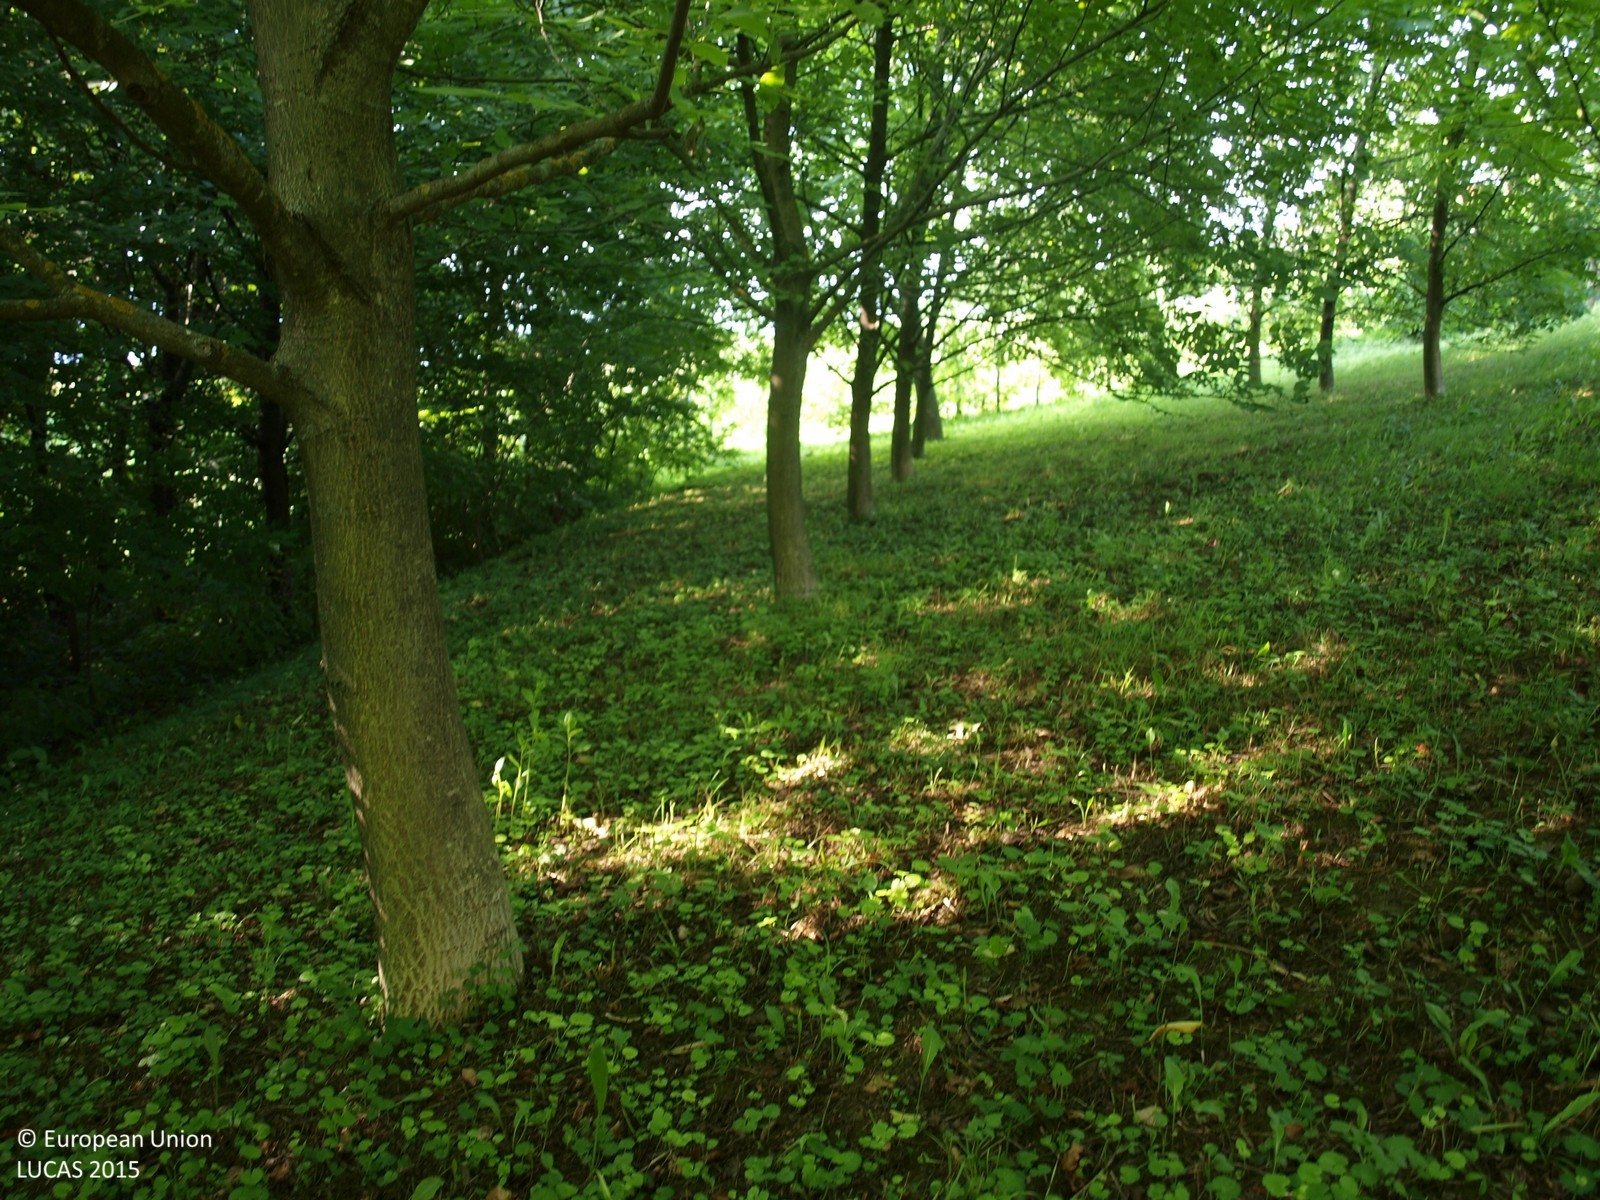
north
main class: Cropland
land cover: Nuts trees
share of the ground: 50 - 75 %
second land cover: Grassland without tree/shrub cover
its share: > 75 %
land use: Agriculture (excluding fallow land and kitchen gardens)
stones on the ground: < 10 %
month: June
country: HR
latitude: 46.1620
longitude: 16.3584
